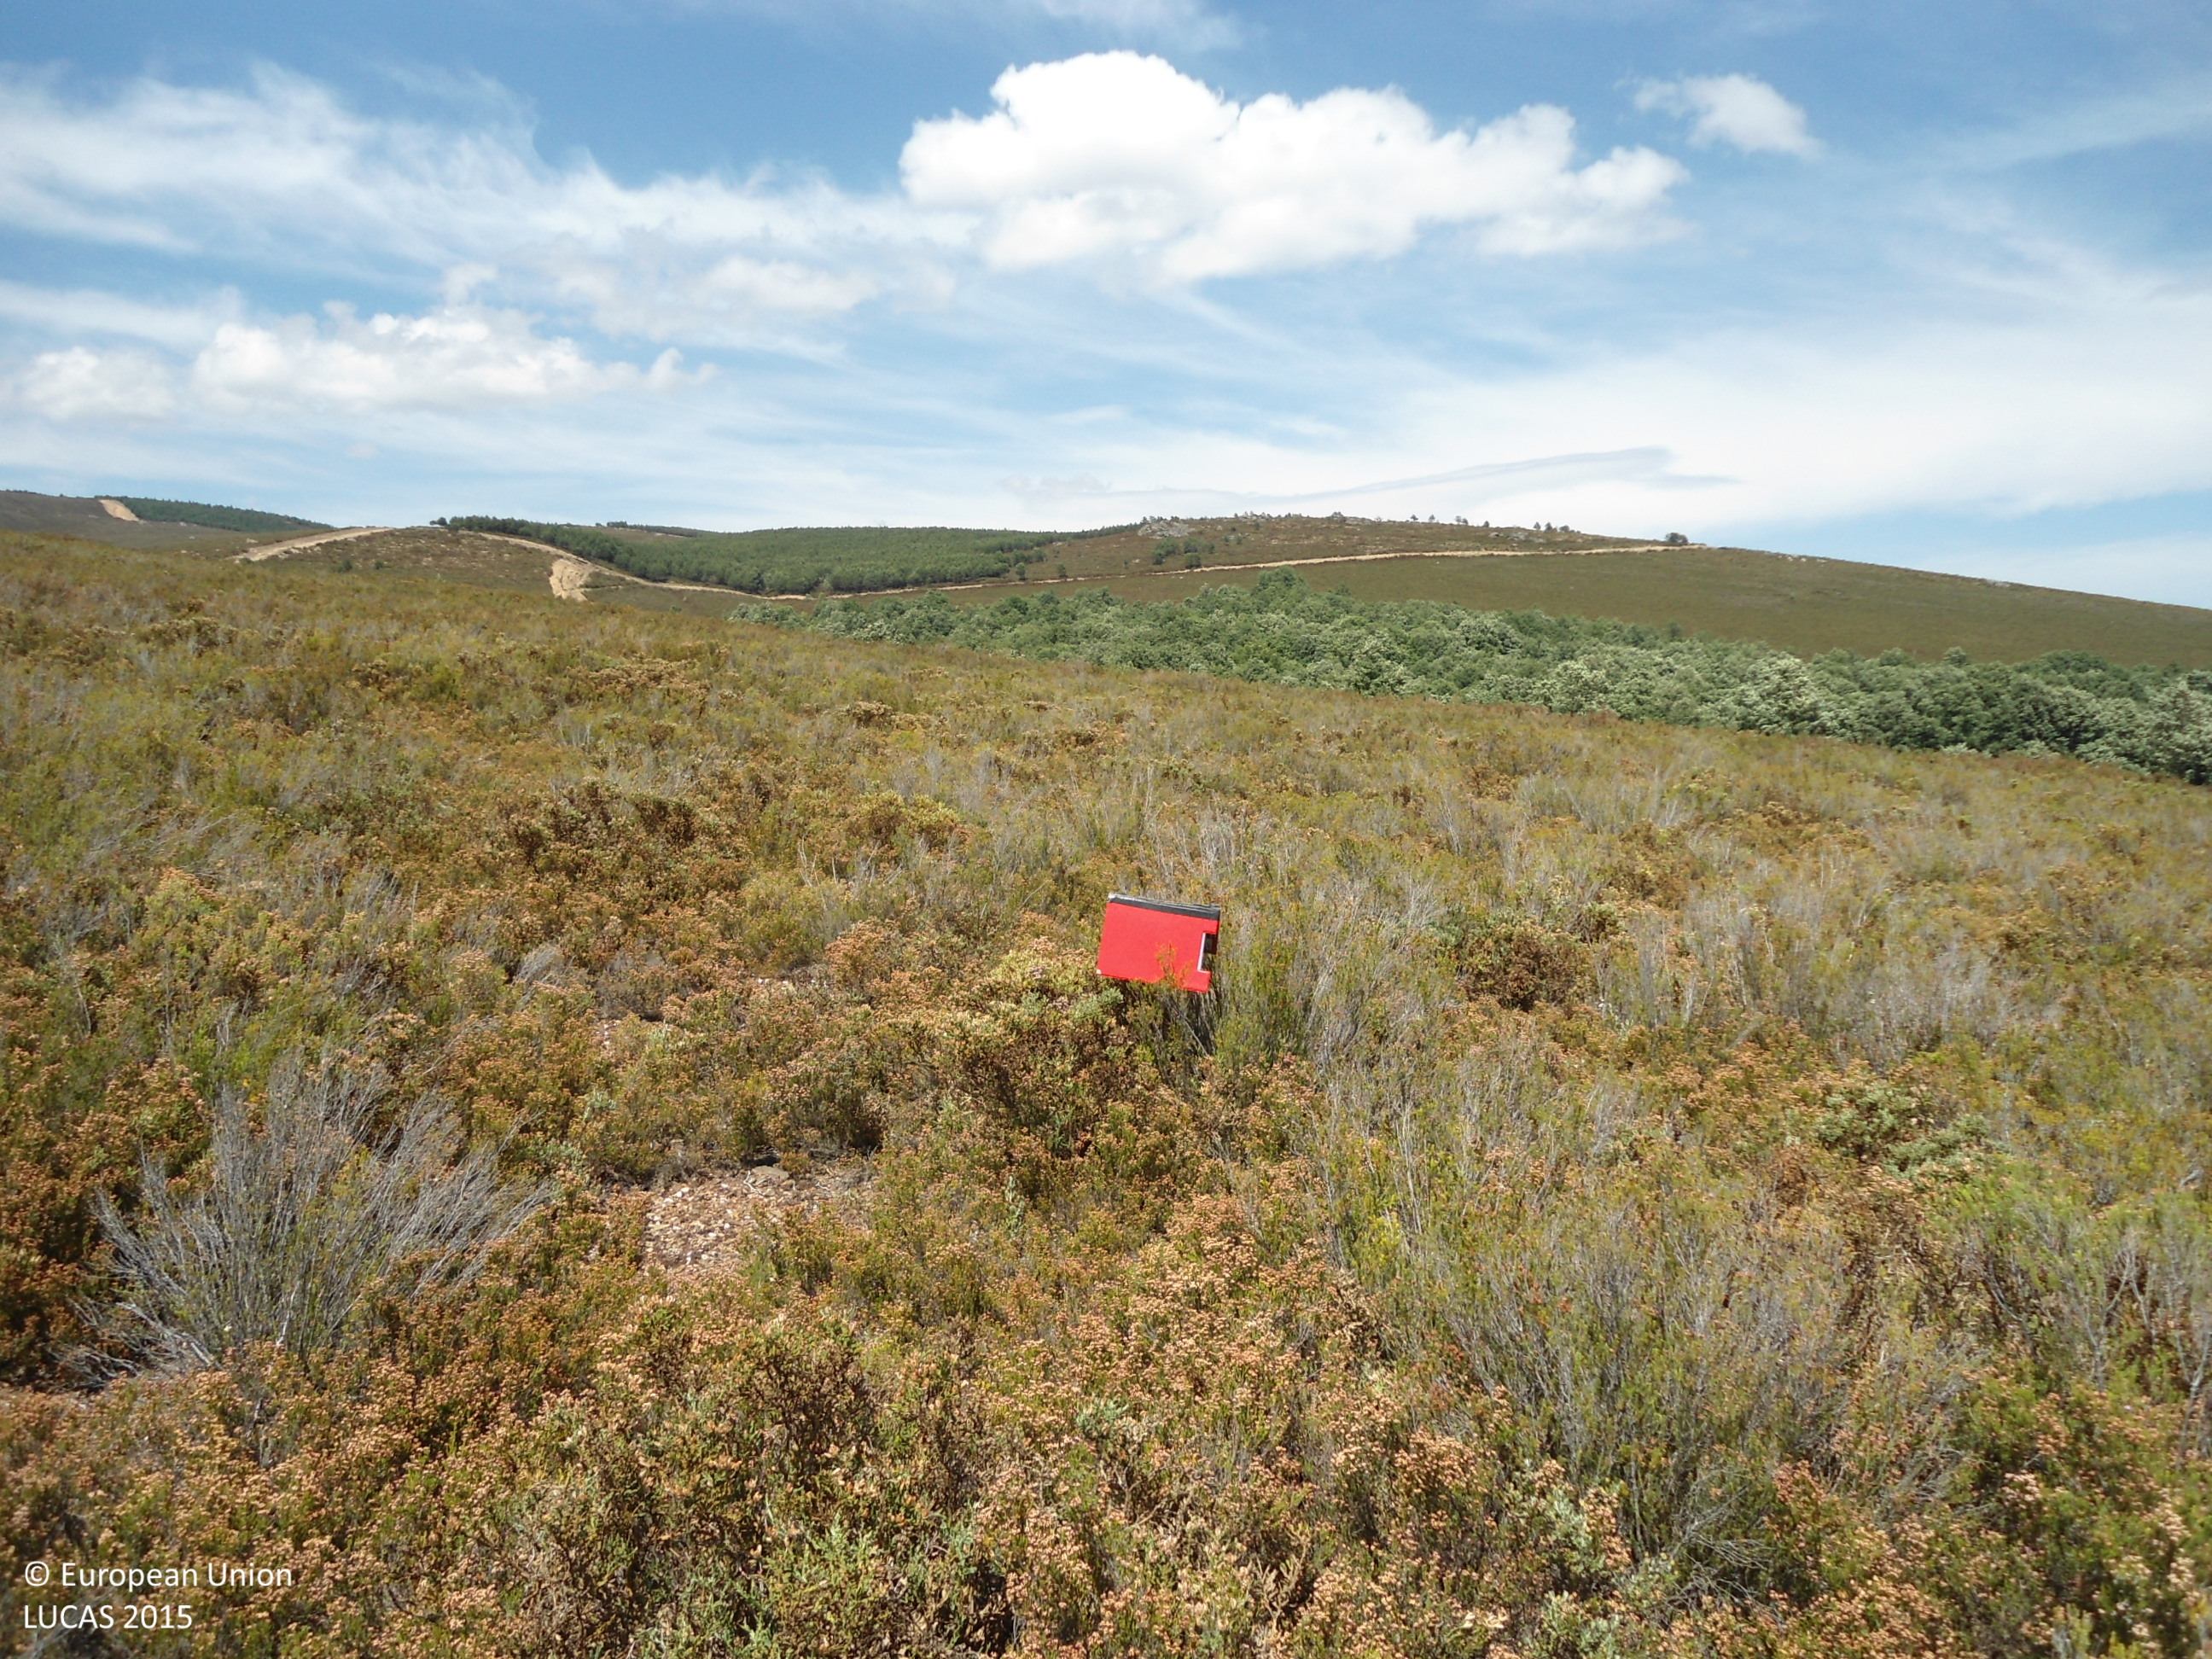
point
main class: Shrubland
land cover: Shrubland without tree cover
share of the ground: > 75 %
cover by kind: shrubs 95 %, consolidated bare surface 5 %
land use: Semi-natural and natural areas not in use
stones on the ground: > 50 %
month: June
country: ES
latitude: 42.1409
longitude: -6.5812
